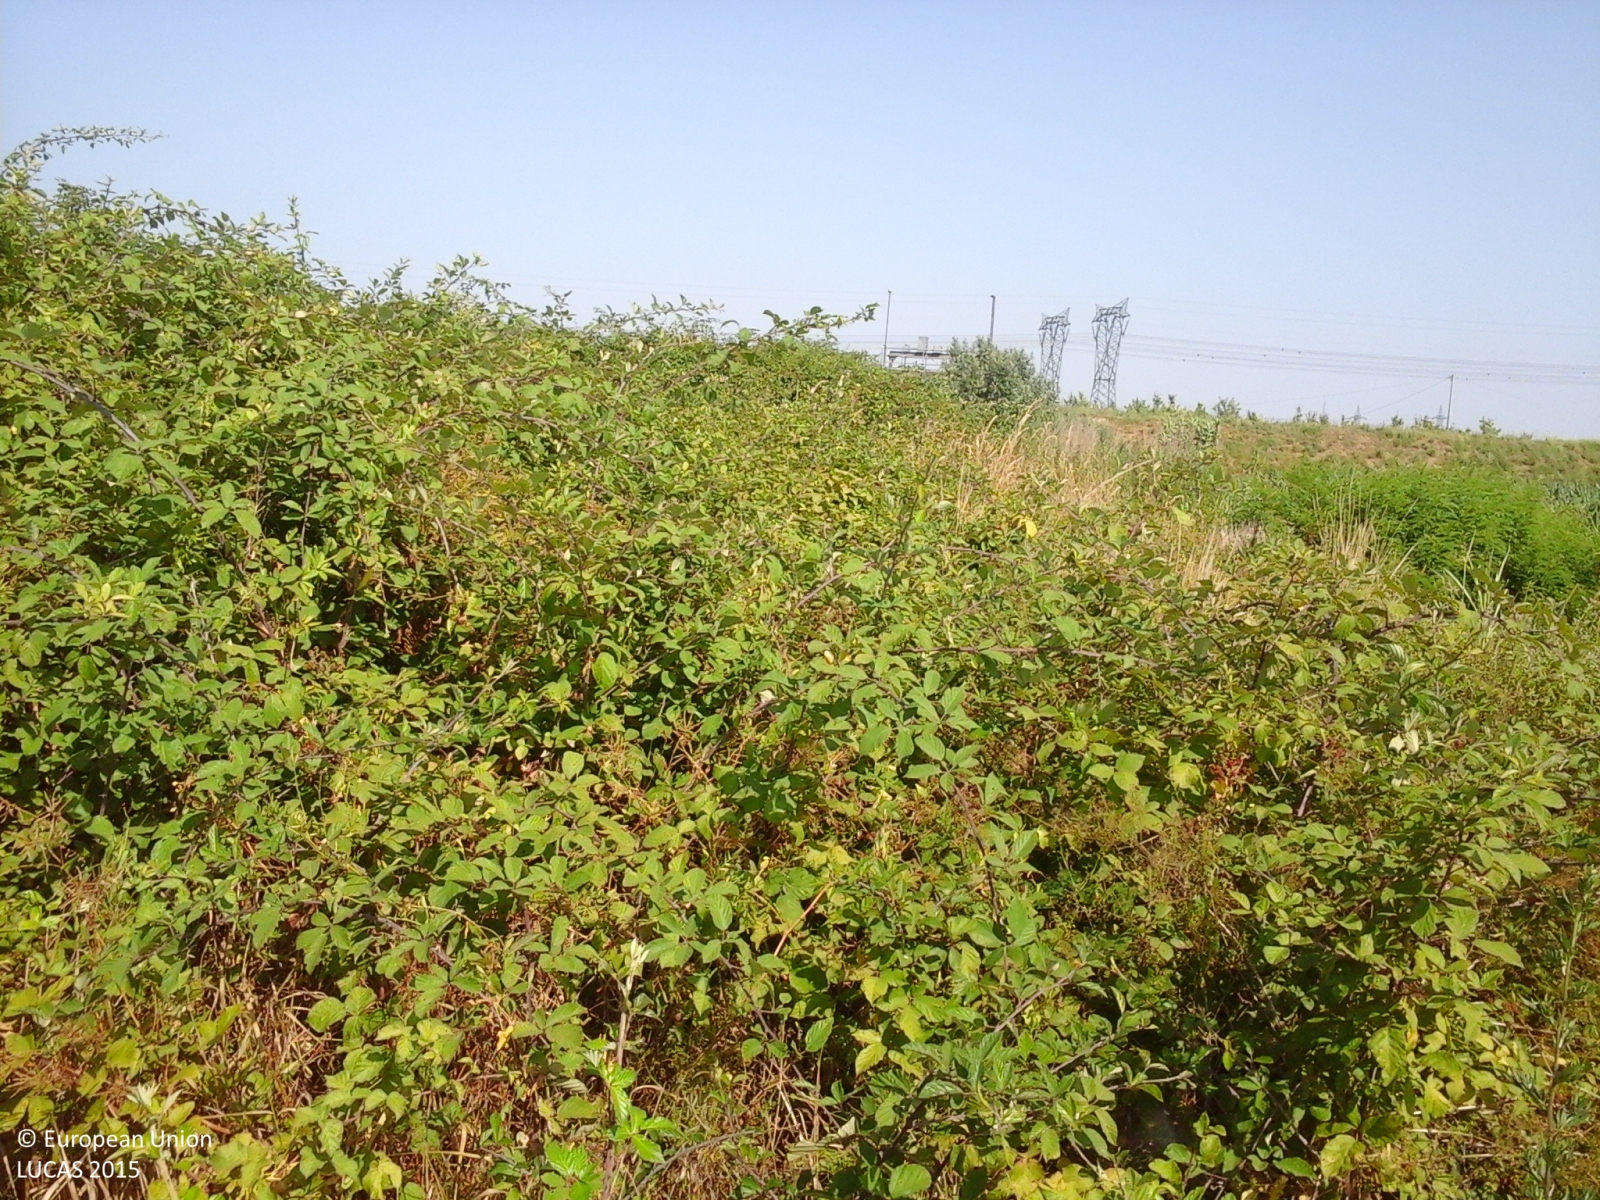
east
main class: Grassland
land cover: Spontaneously vegetated surfaces
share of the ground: > 75 %
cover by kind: herbaceous plants 100 %
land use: Fallow land
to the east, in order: Spontaneously vegetated surfaces; Tracks; Grassland without tree/shrub cover; Inland fresh running water; Grassland without tree/shrub cover; Tracks; Nurseries; Grassland without tree/shrub cover
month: July
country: IT
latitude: 43.8403
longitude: 11.0297
